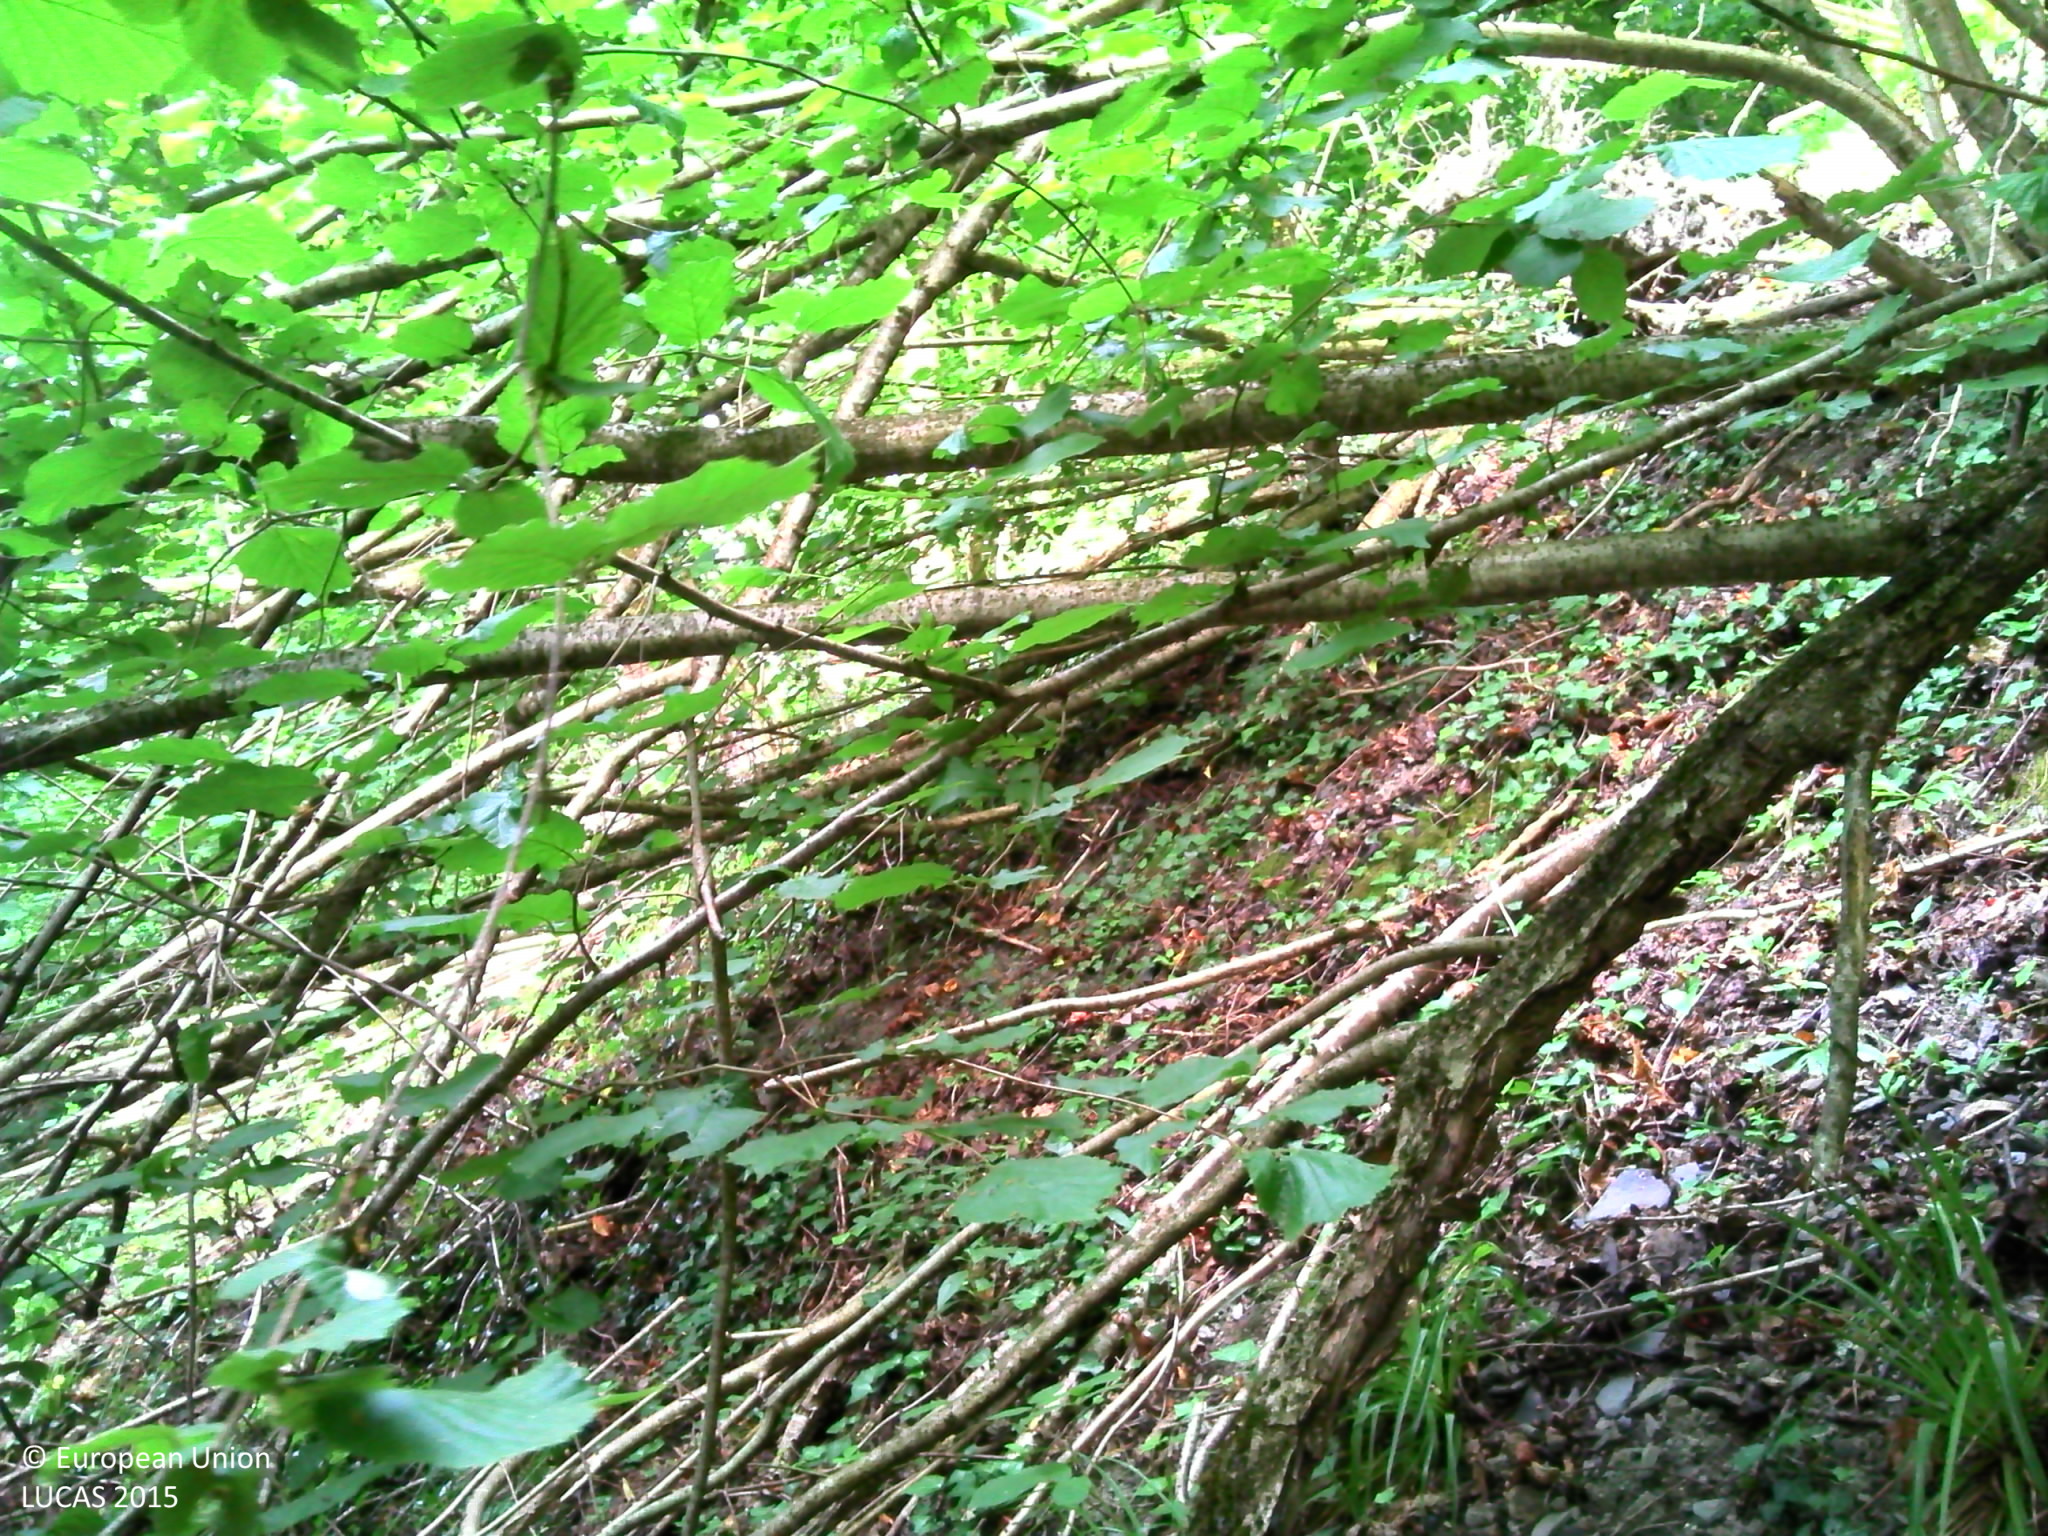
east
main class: Woodland
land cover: Broadleaved woodland
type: mesophytic deciduous forest
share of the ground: > 75 %
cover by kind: broadleaved forest trees 90 %, shrubs 5 %, herbaceous plants 5 %
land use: Forestry
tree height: > 5 m
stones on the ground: 10 - 25 %
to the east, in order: Broadleaved woodland; Rivers and streams; Broadleaved woodland; Tracks; Spontaneously vegetated surfaces; Broadleaved woodland
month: July
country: FR
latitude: 42.9823
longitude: -0.1198
